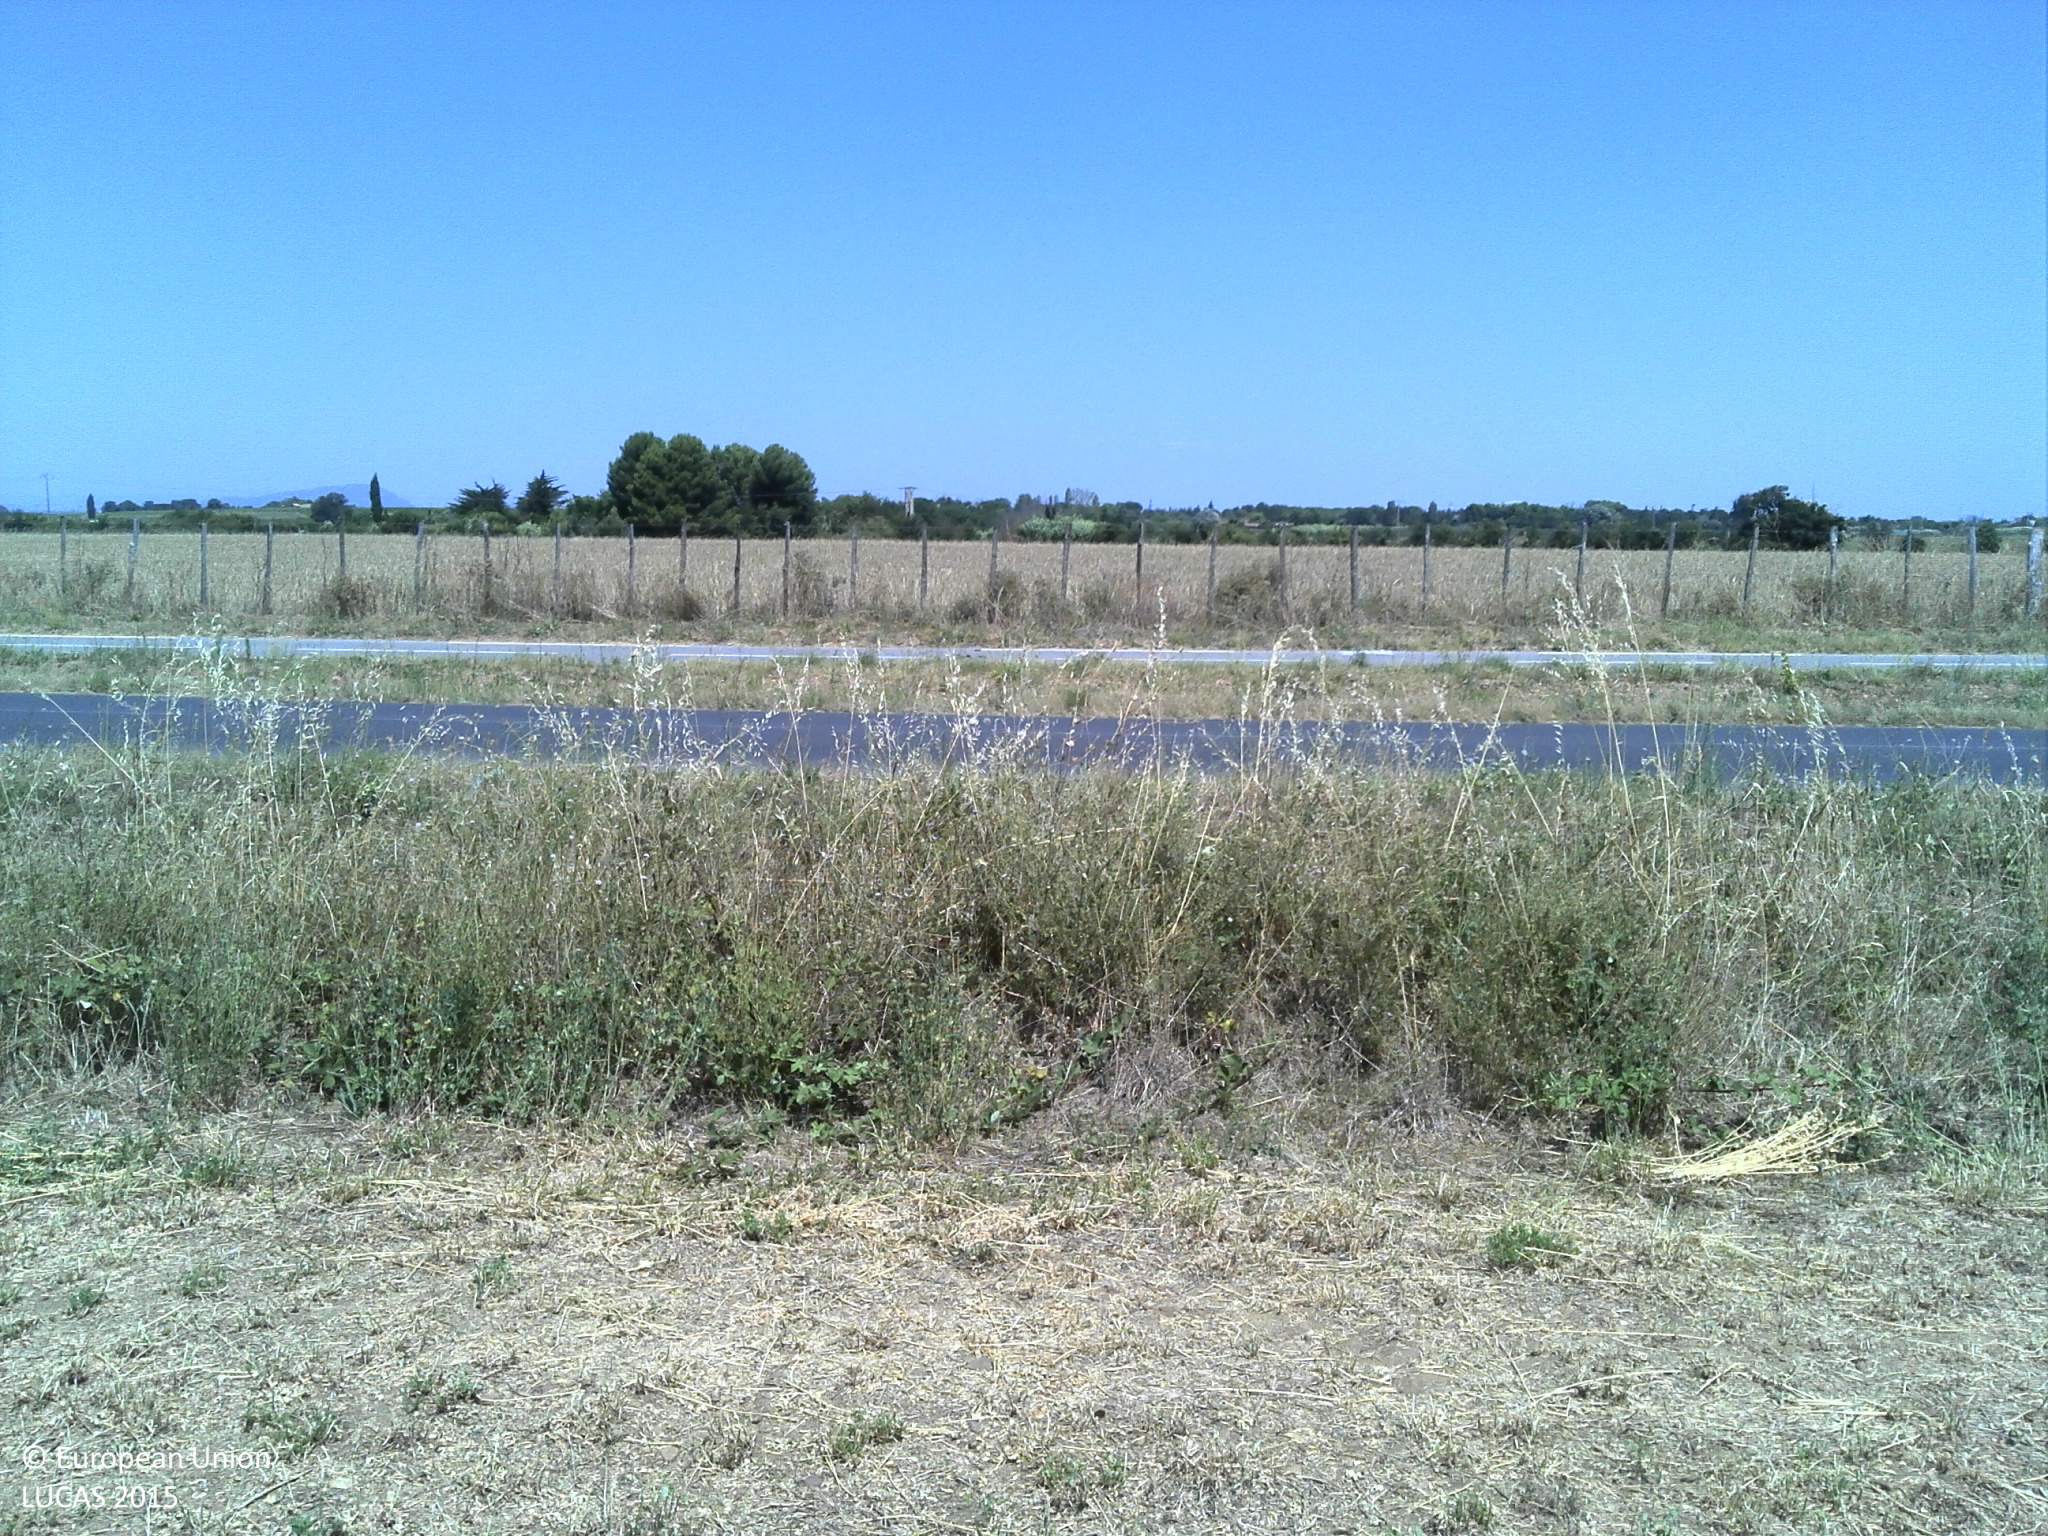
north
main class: Cropland
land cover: Temporary grasslands
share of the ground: > 75 %
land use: Agriculture (excluding fallow land and kitchen gardens)
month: July
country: FR
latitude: 43.5579
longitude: 3.9312
